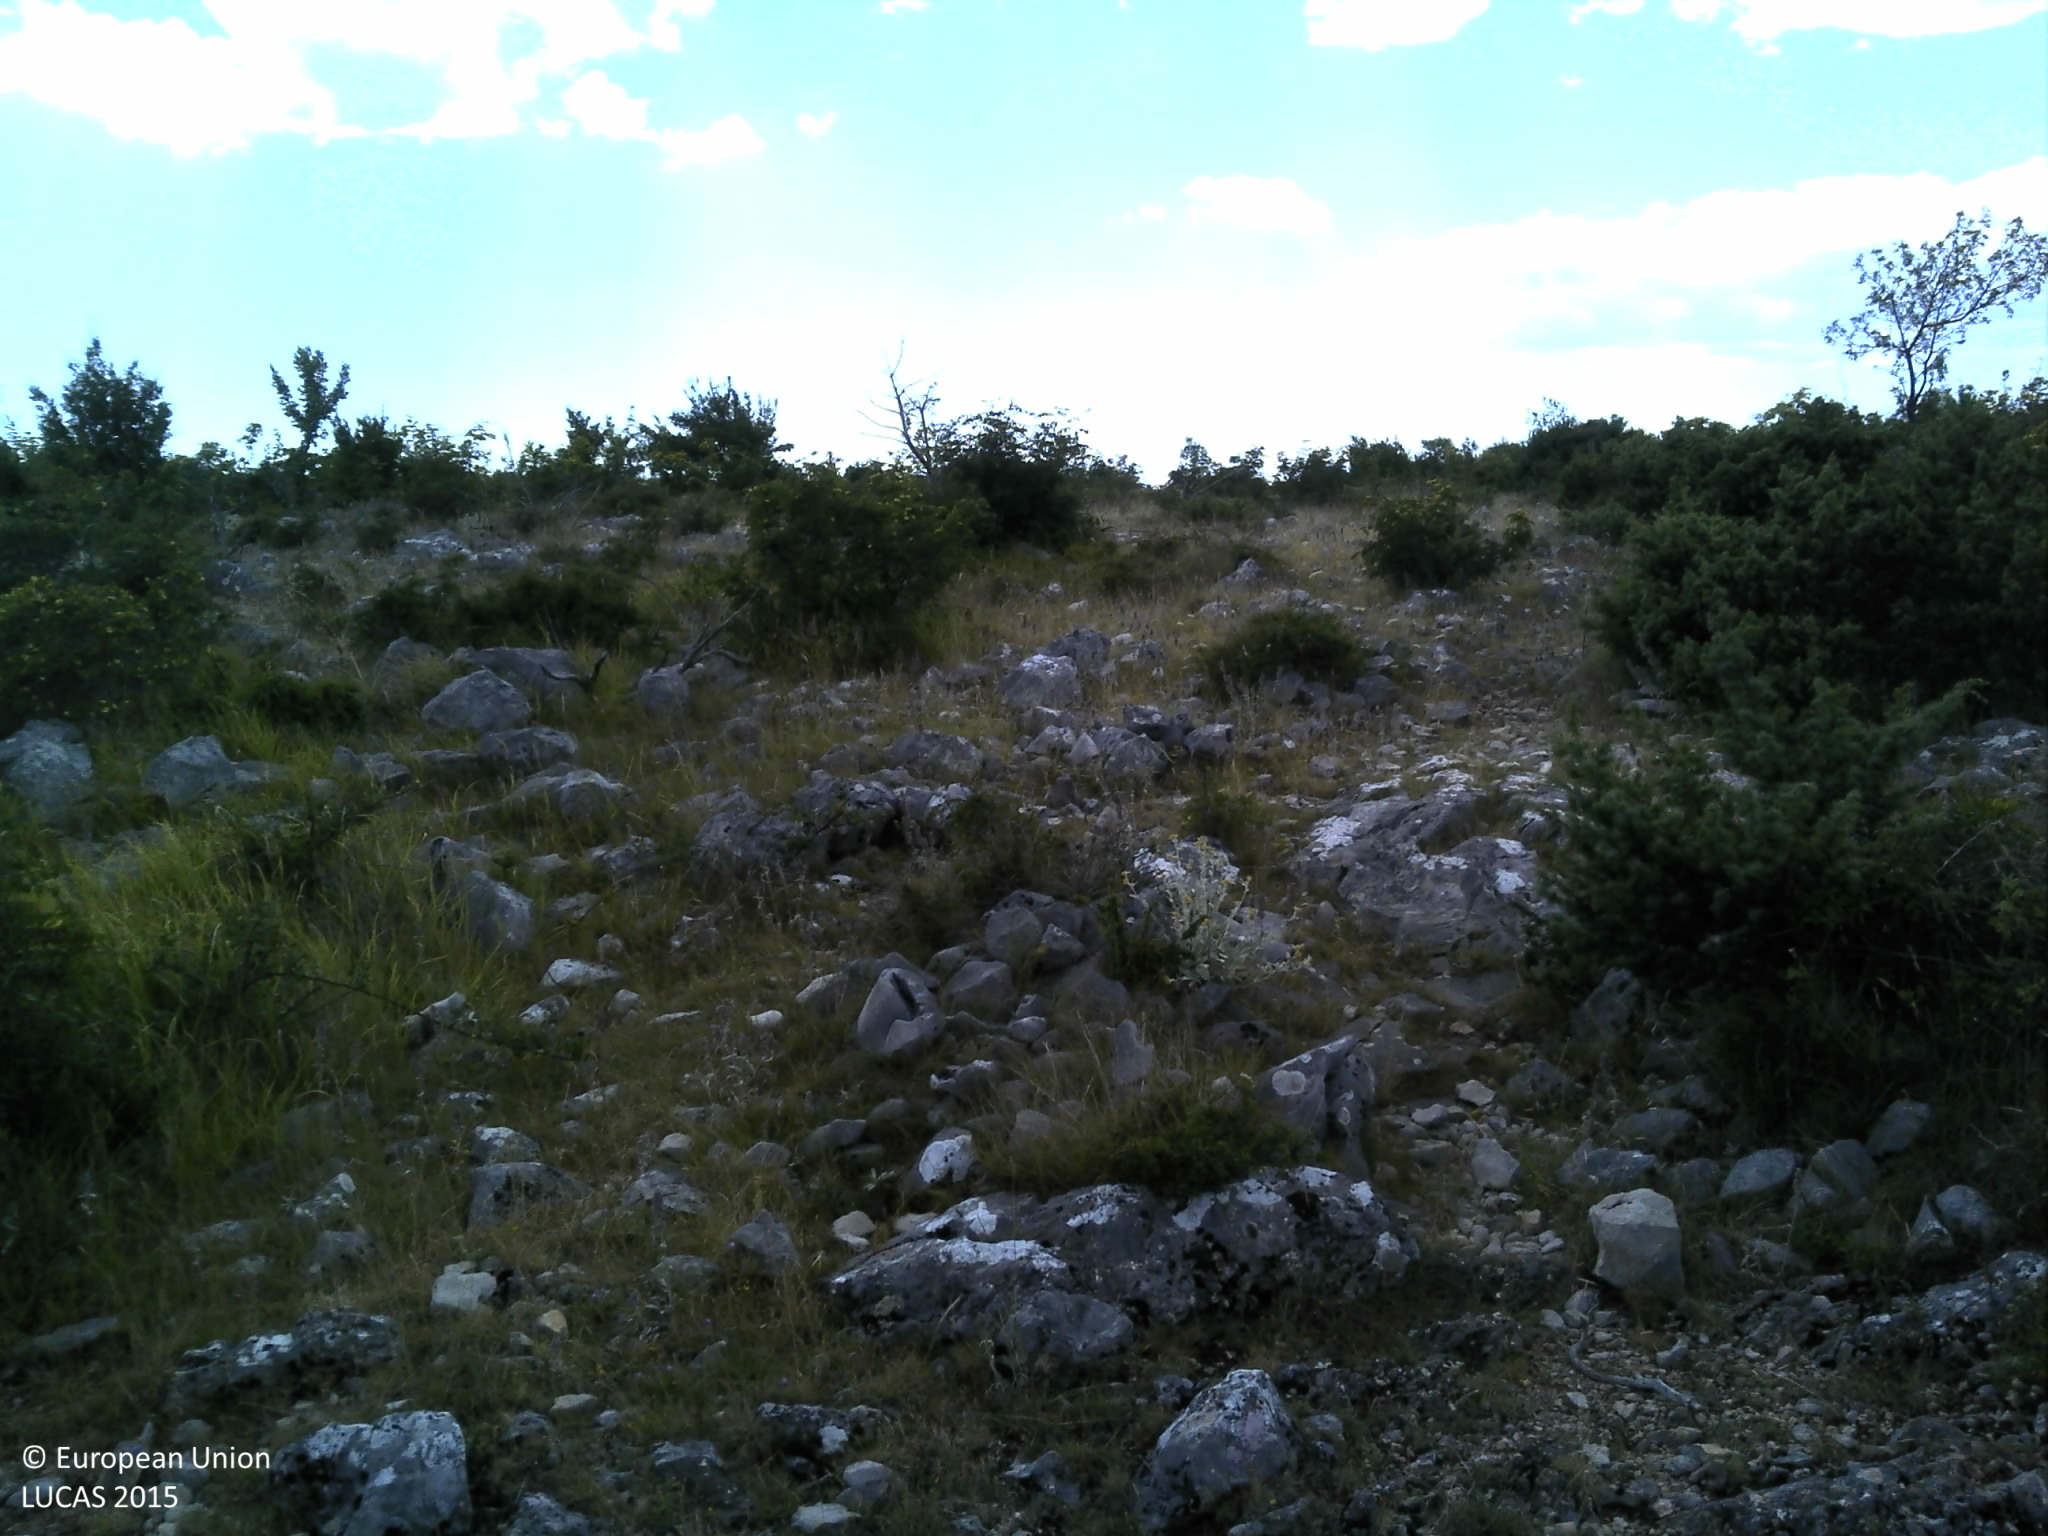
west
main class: Shrubland
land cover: Shrubland with sparse tree cover
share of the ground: 25 - 50 %
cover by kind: shrubs 35 %, herbaceous plants 30 %, consolidated bare surface 25 %, broadleaved forest trees 5 %, unconsolidated bare surface 5 %
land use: Semi-natural and natural areas not in use
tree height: < 5 m
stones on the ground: < 10 %
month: July
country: HR
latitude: 44.0209
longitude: 16.1926
